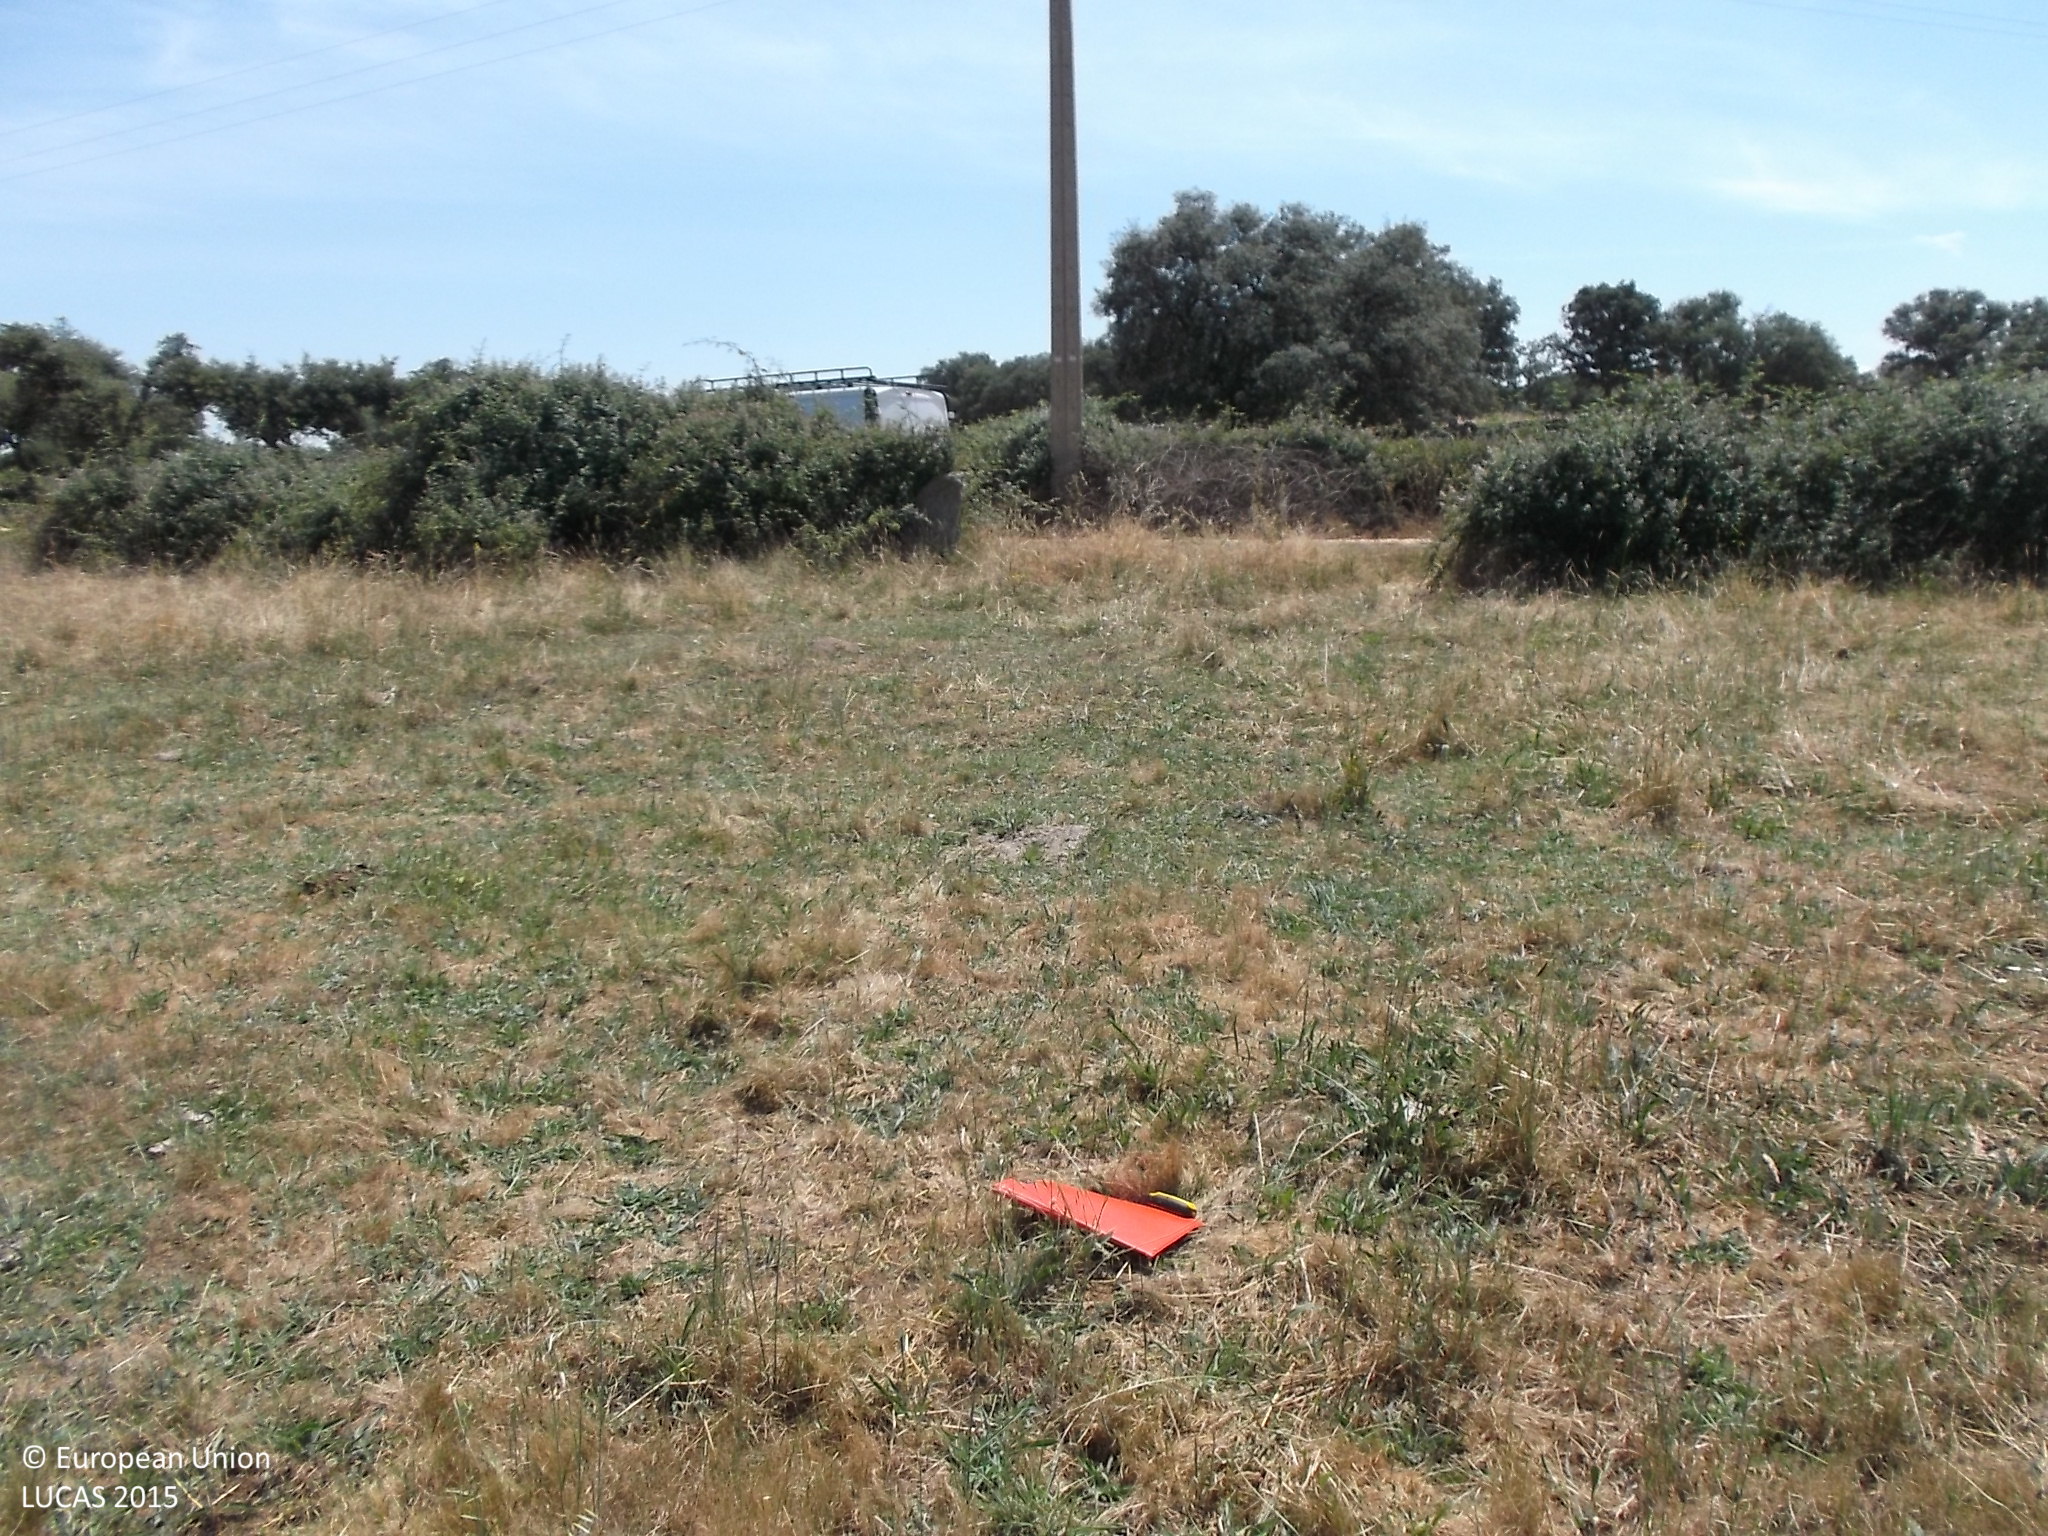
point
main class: Grassland
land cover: Grassland without tree/shrub cover
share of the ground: > 75 %
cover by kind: herbaceous plants 100 %
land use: Agriculture (excluding fallow land and kitchen gardens)
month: June
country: ES
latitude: 41.2624
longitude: -5.9989
